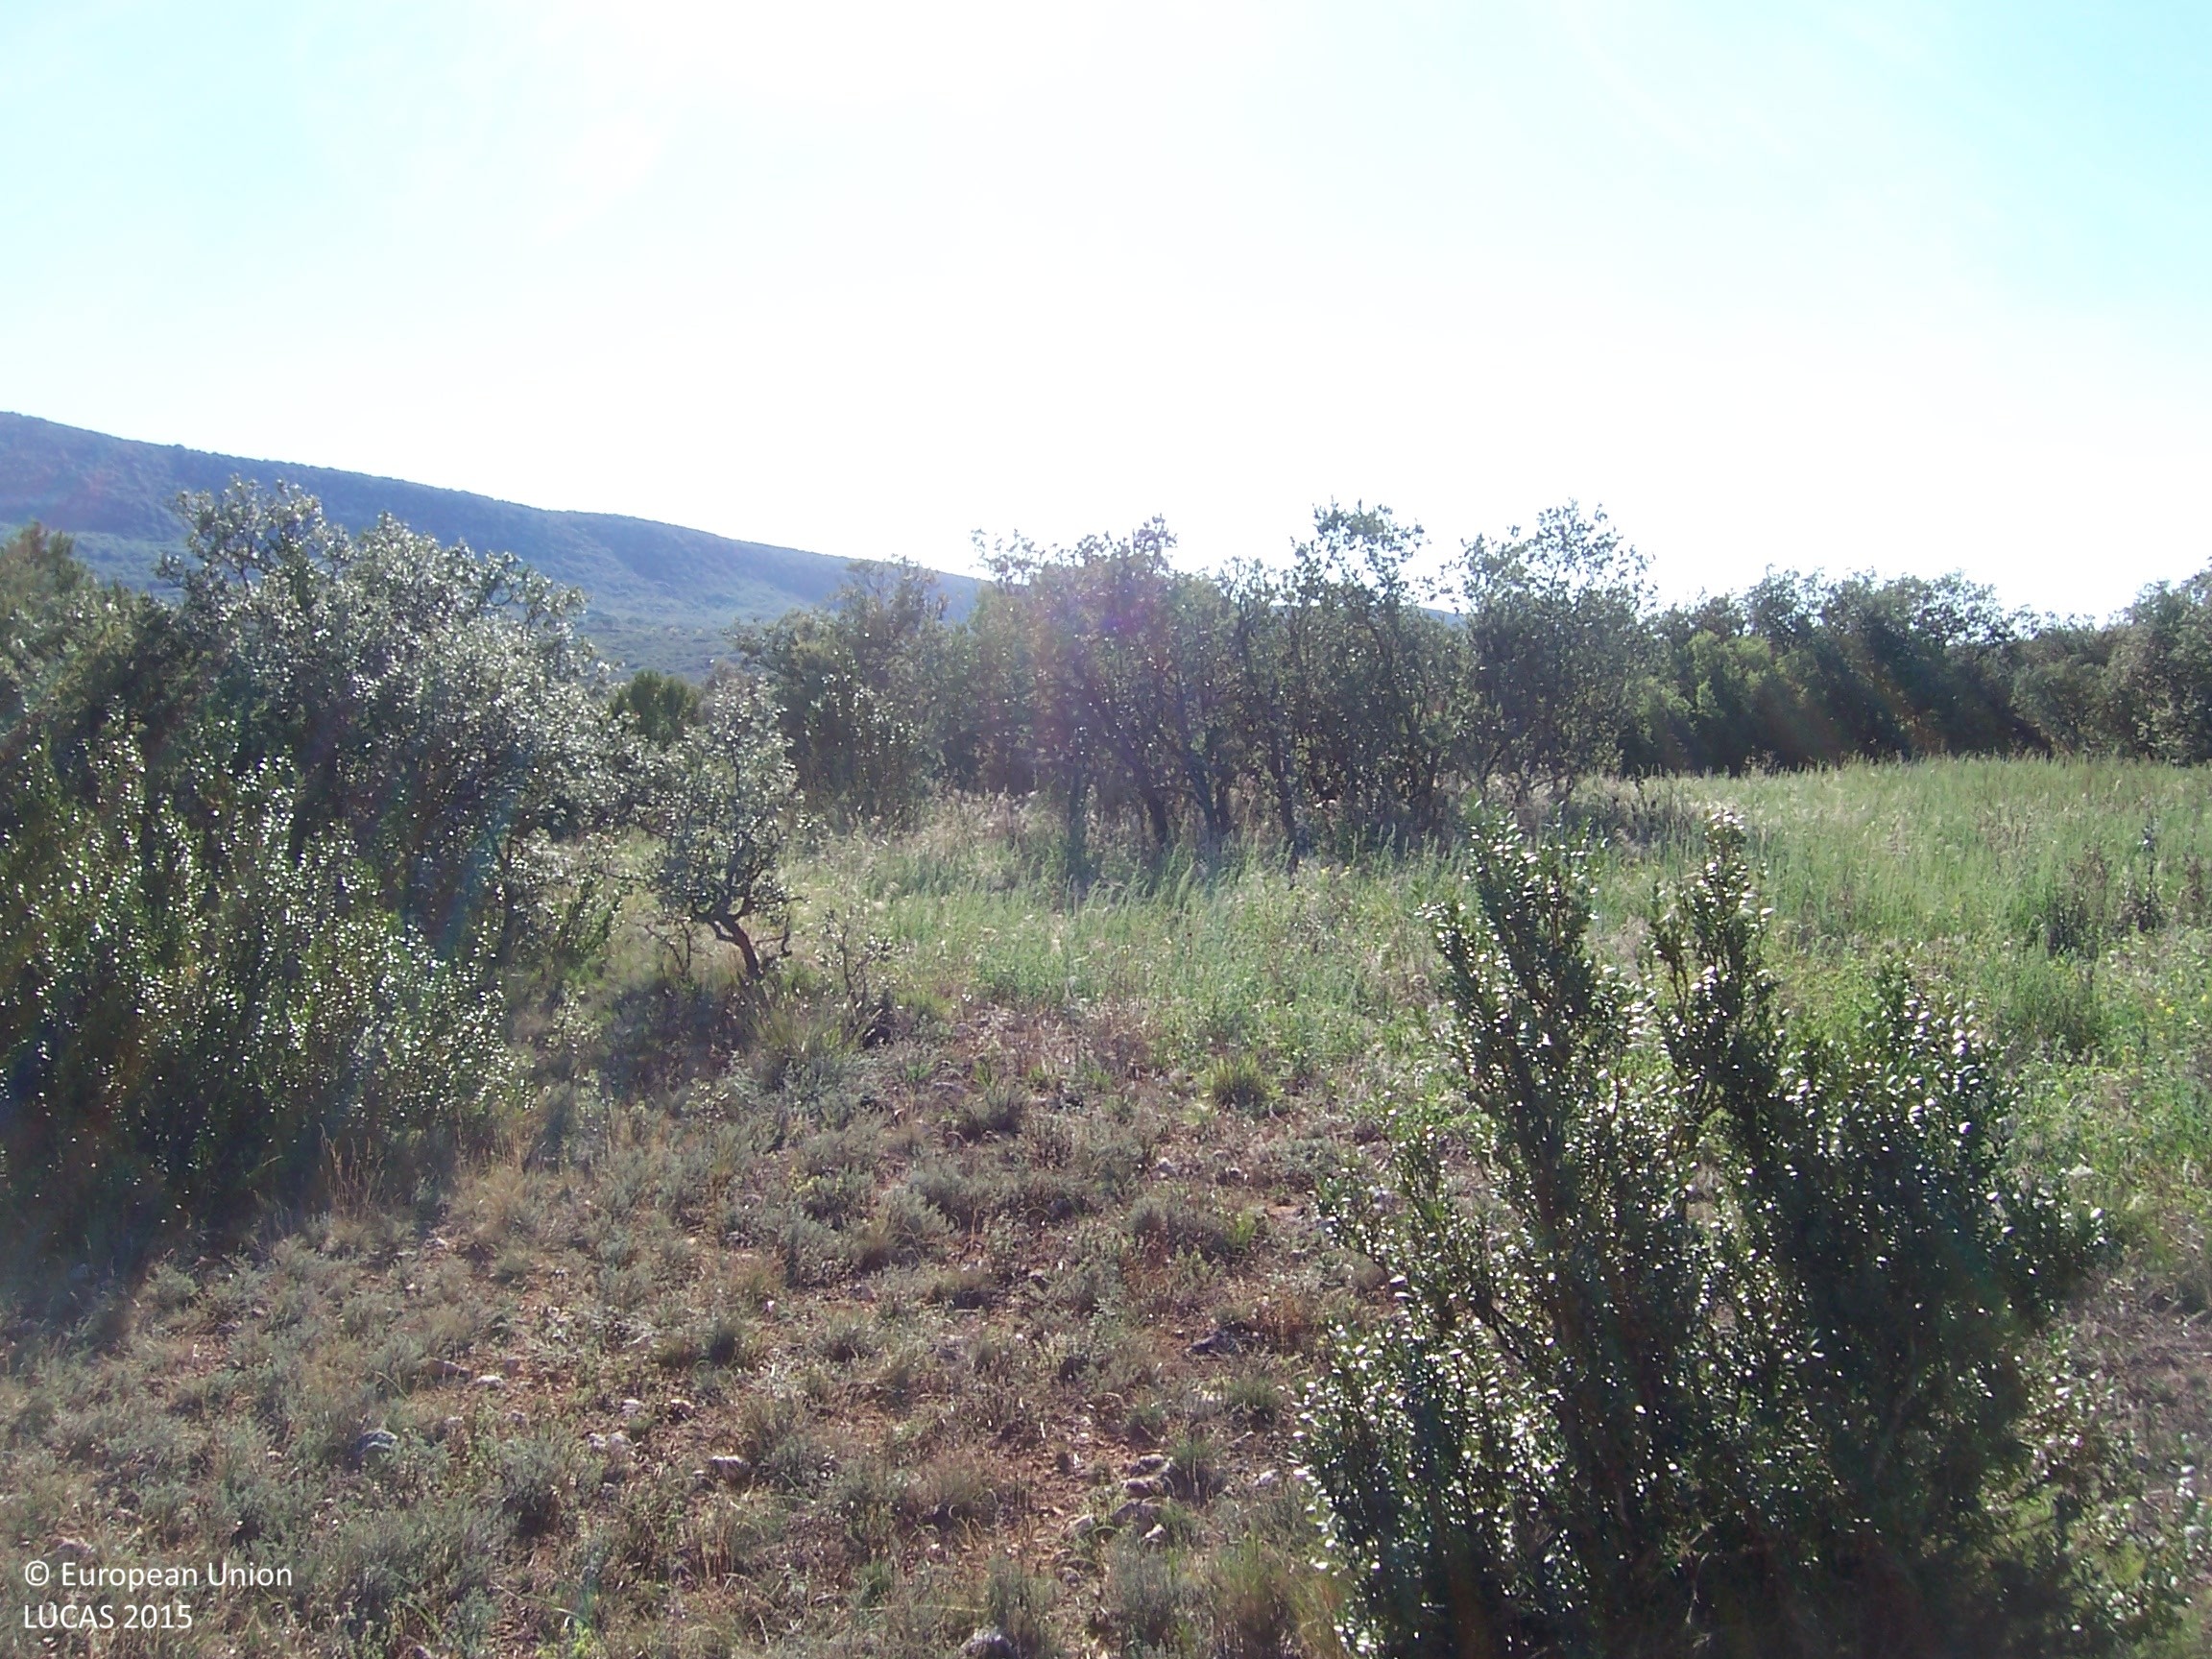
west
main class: Woodland
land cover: Broadleaved woodland
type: broadleaved evergreen forest
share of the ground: > 75 %
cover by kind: herbaceous plants 40 %, unconsolidated bare surface 30 %, broadleaved forest trees 20 %, shrubs 10 %
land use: Semi-natural and natural areas not in use
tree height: < 5 m
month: August
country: ES
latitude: 42.0072
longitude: 0.5058
